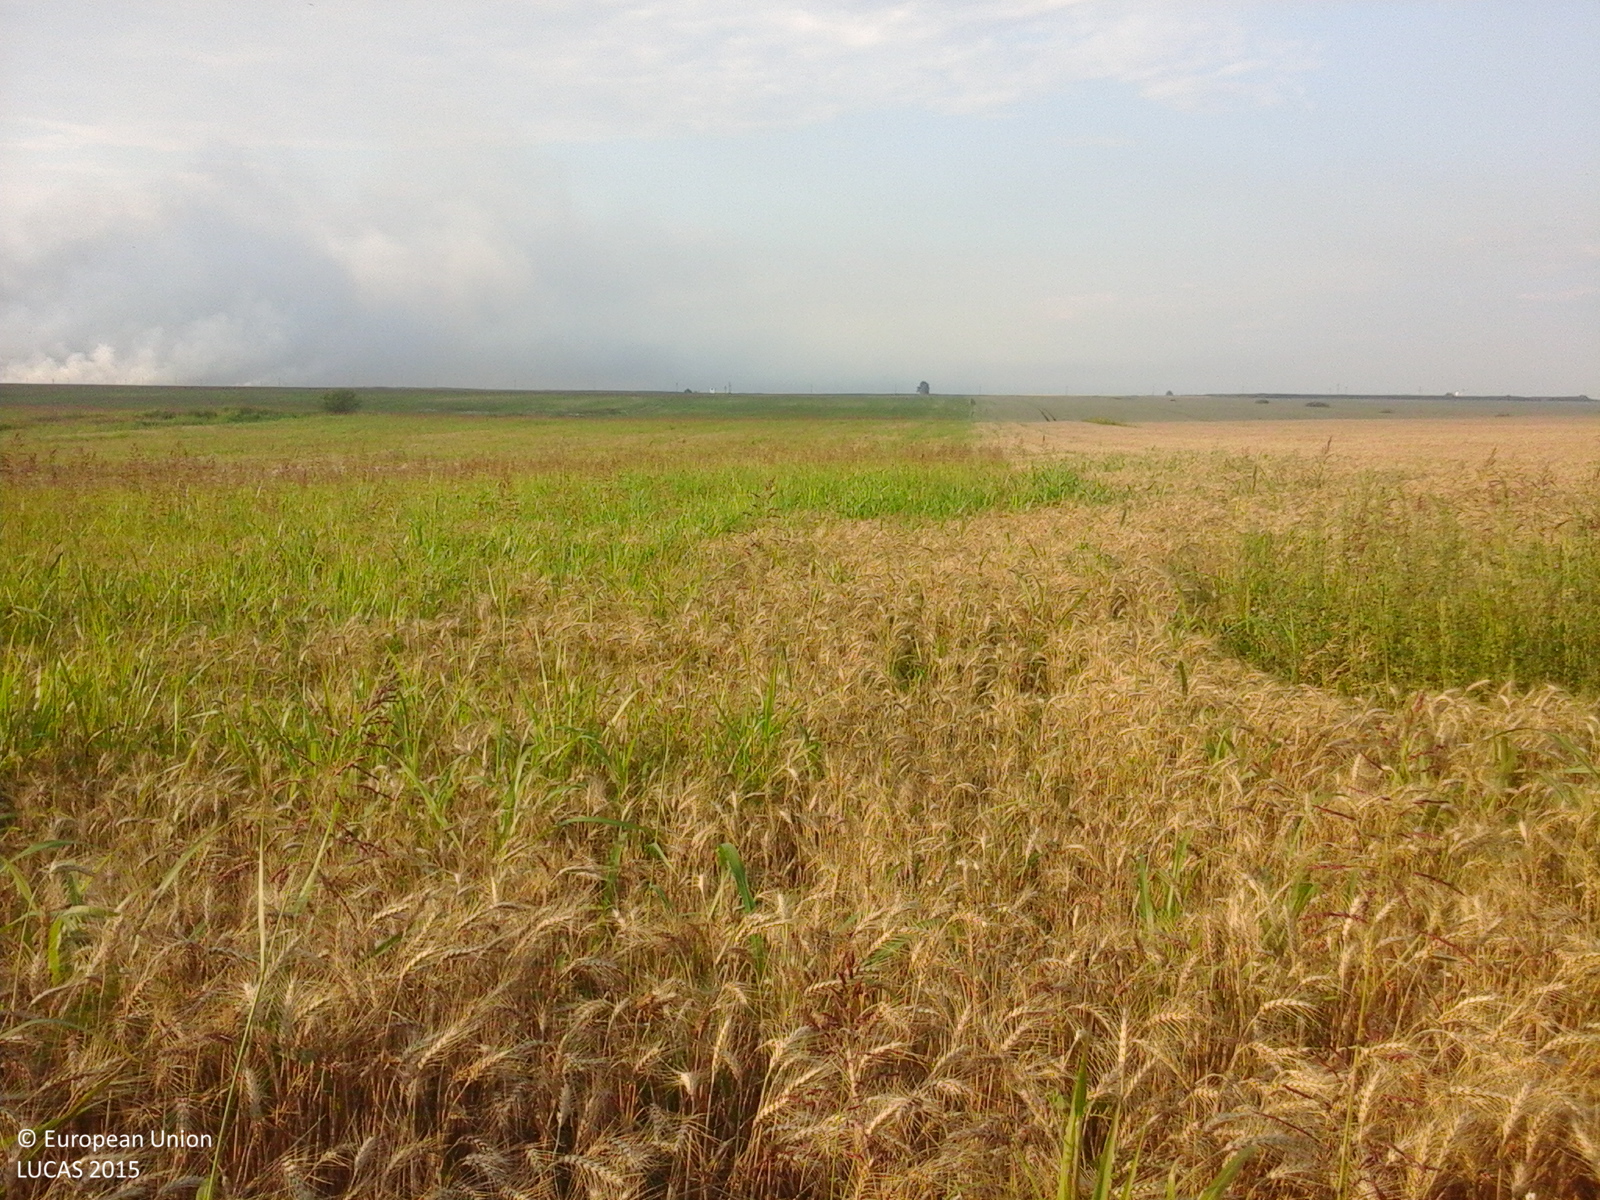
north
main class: Cropland
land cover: Common wheat
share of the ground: > 75 %
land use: Agriculture (excluding fallow land and kitchen gardens)
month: July
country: RO
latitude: 43.7318
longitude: 25.5925
